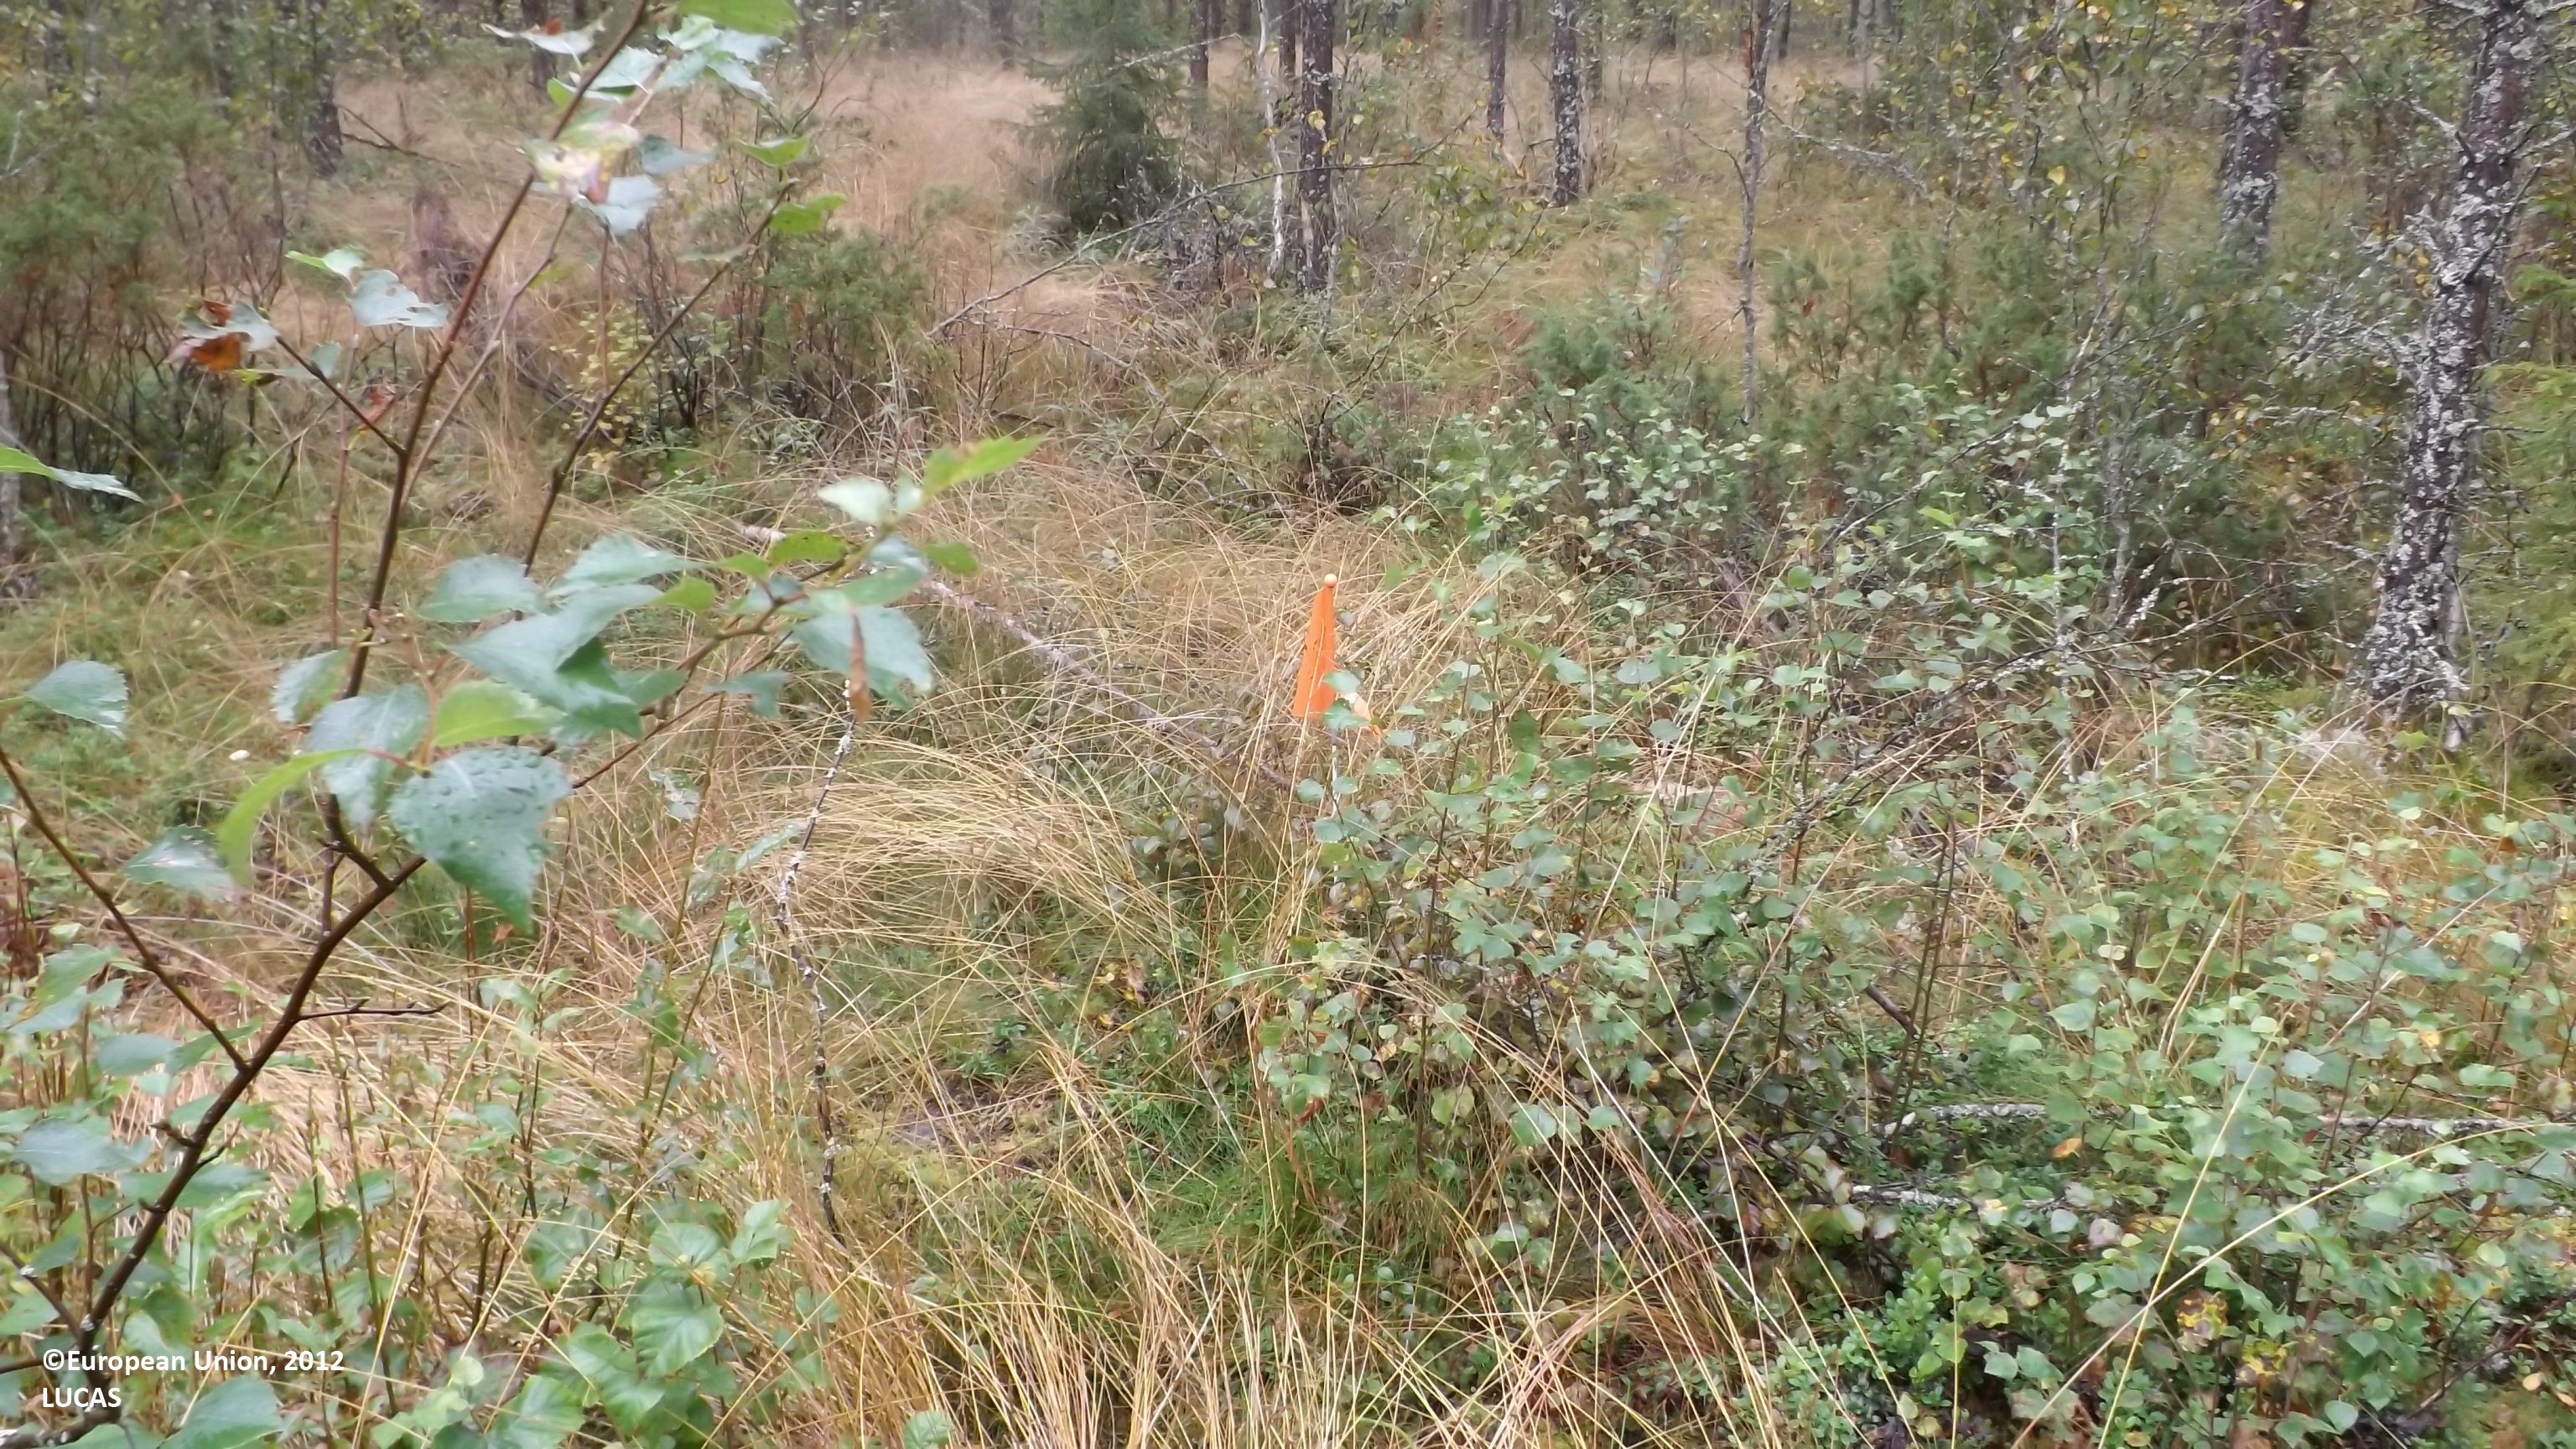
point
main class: Woodland
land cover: Pine dominated mixed woodland
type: boreal forest
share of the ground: 25 - 50 %
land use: Forestry
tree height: > 5 m
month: August
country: FI
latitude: 63.7912
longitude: 23.5971
